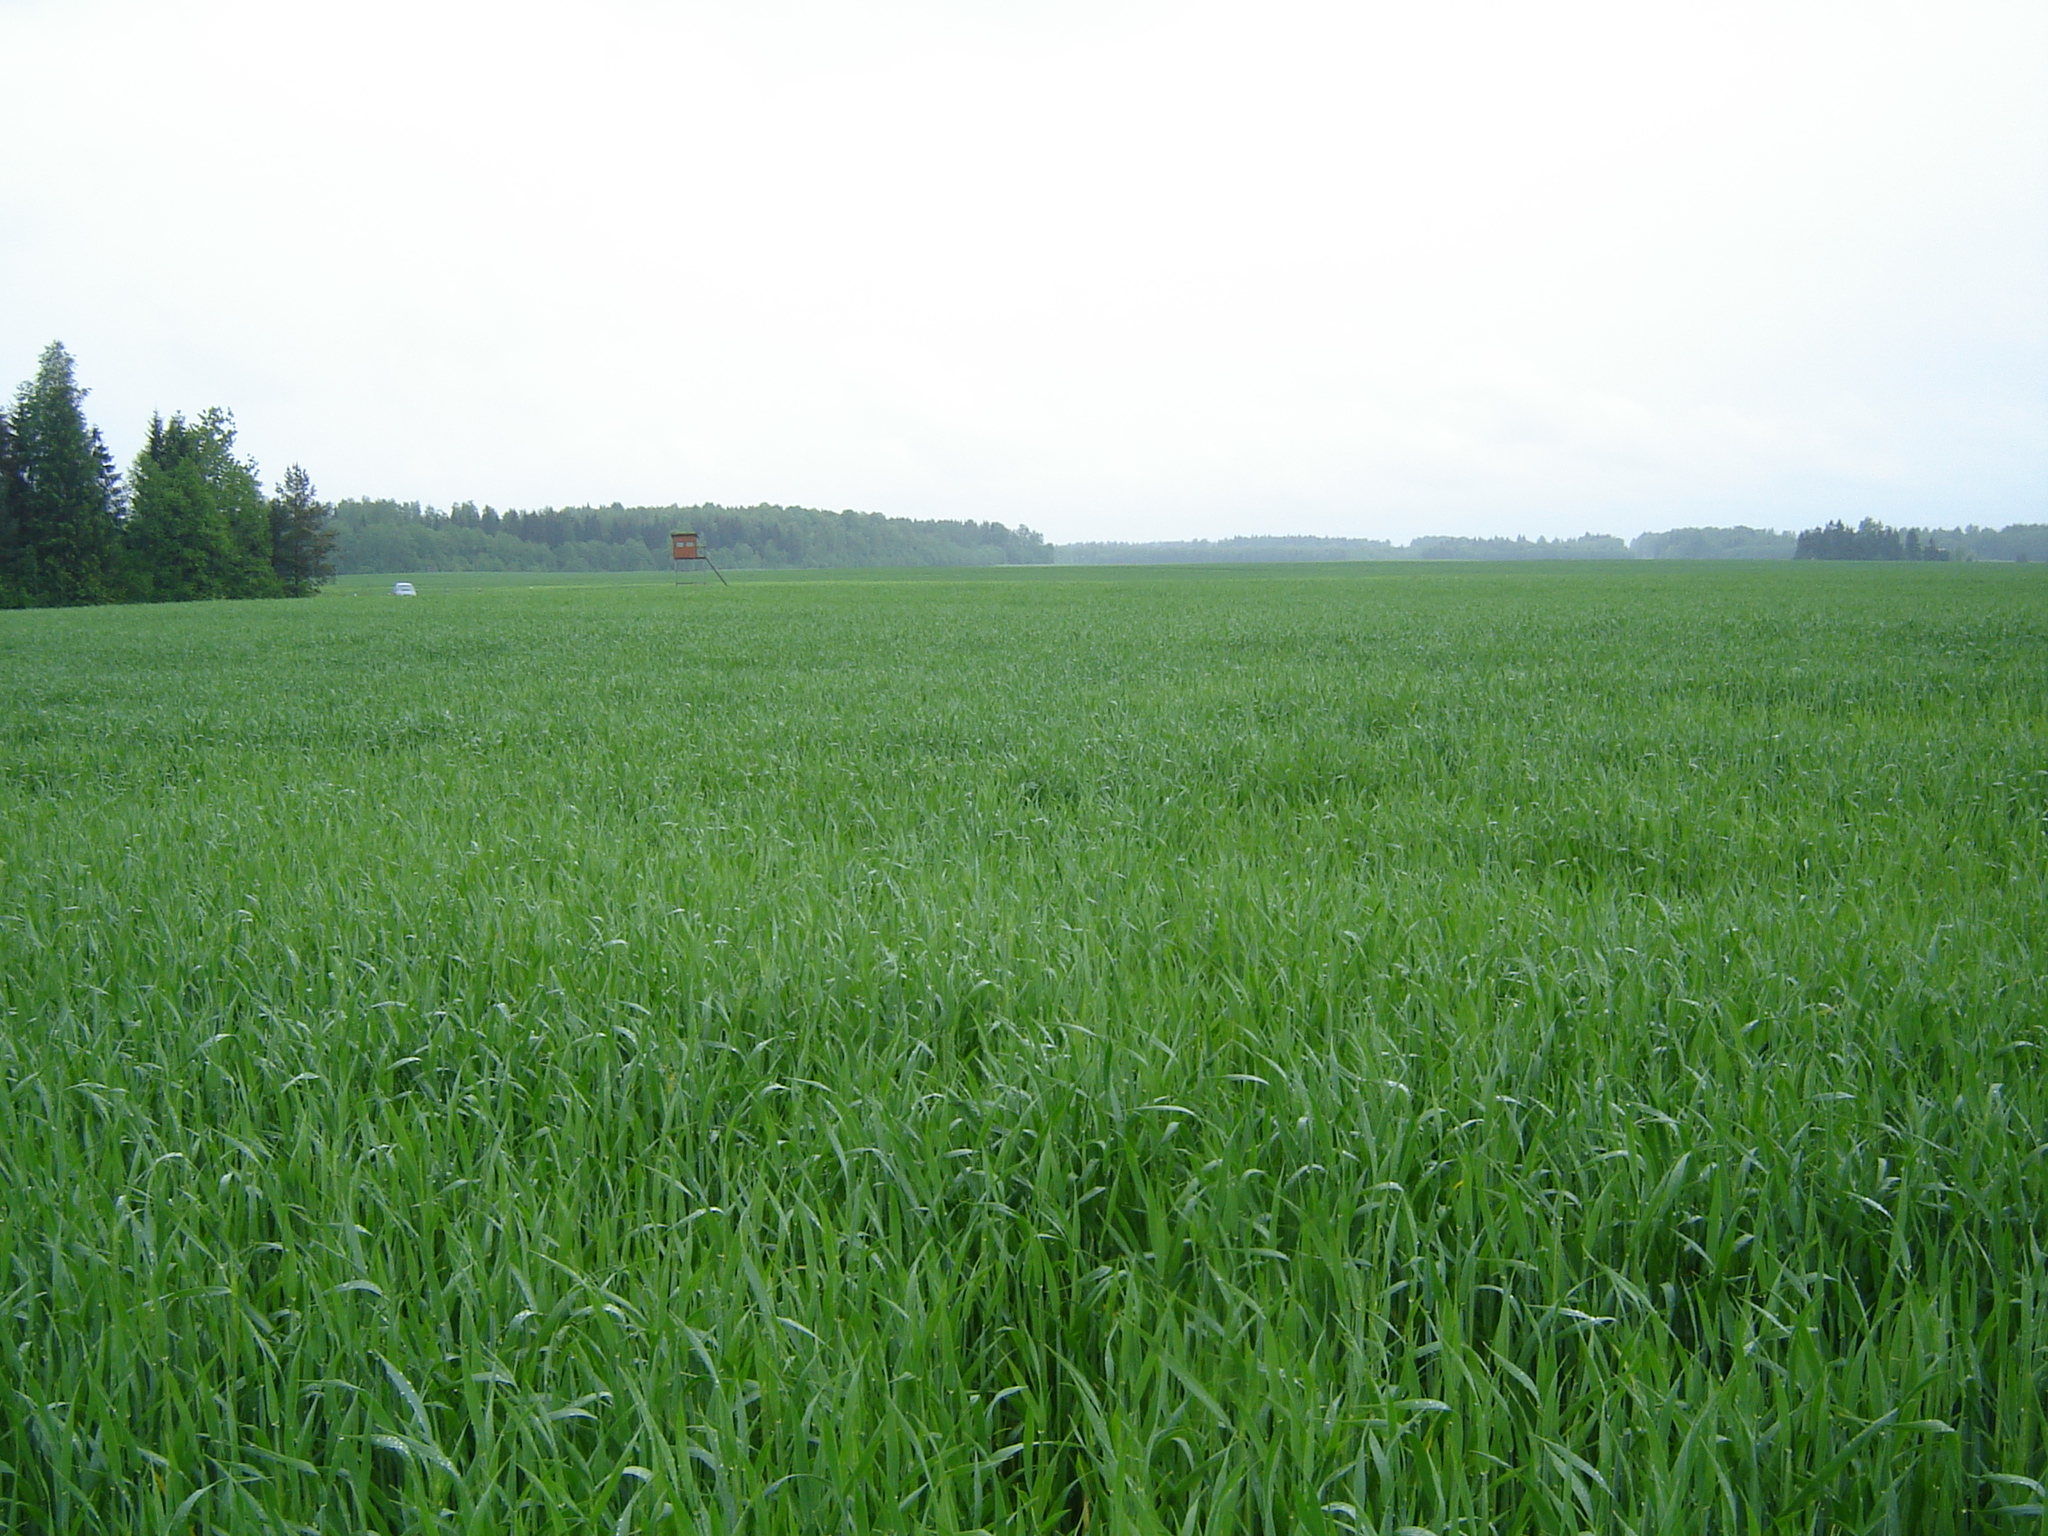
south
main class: Cropland
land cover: Common wheat
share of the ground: > 75 %
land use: Agriculture (excluding fallow land and kitchen gardens)
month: May
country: LT
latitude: 55.9296
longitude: 25.2414
